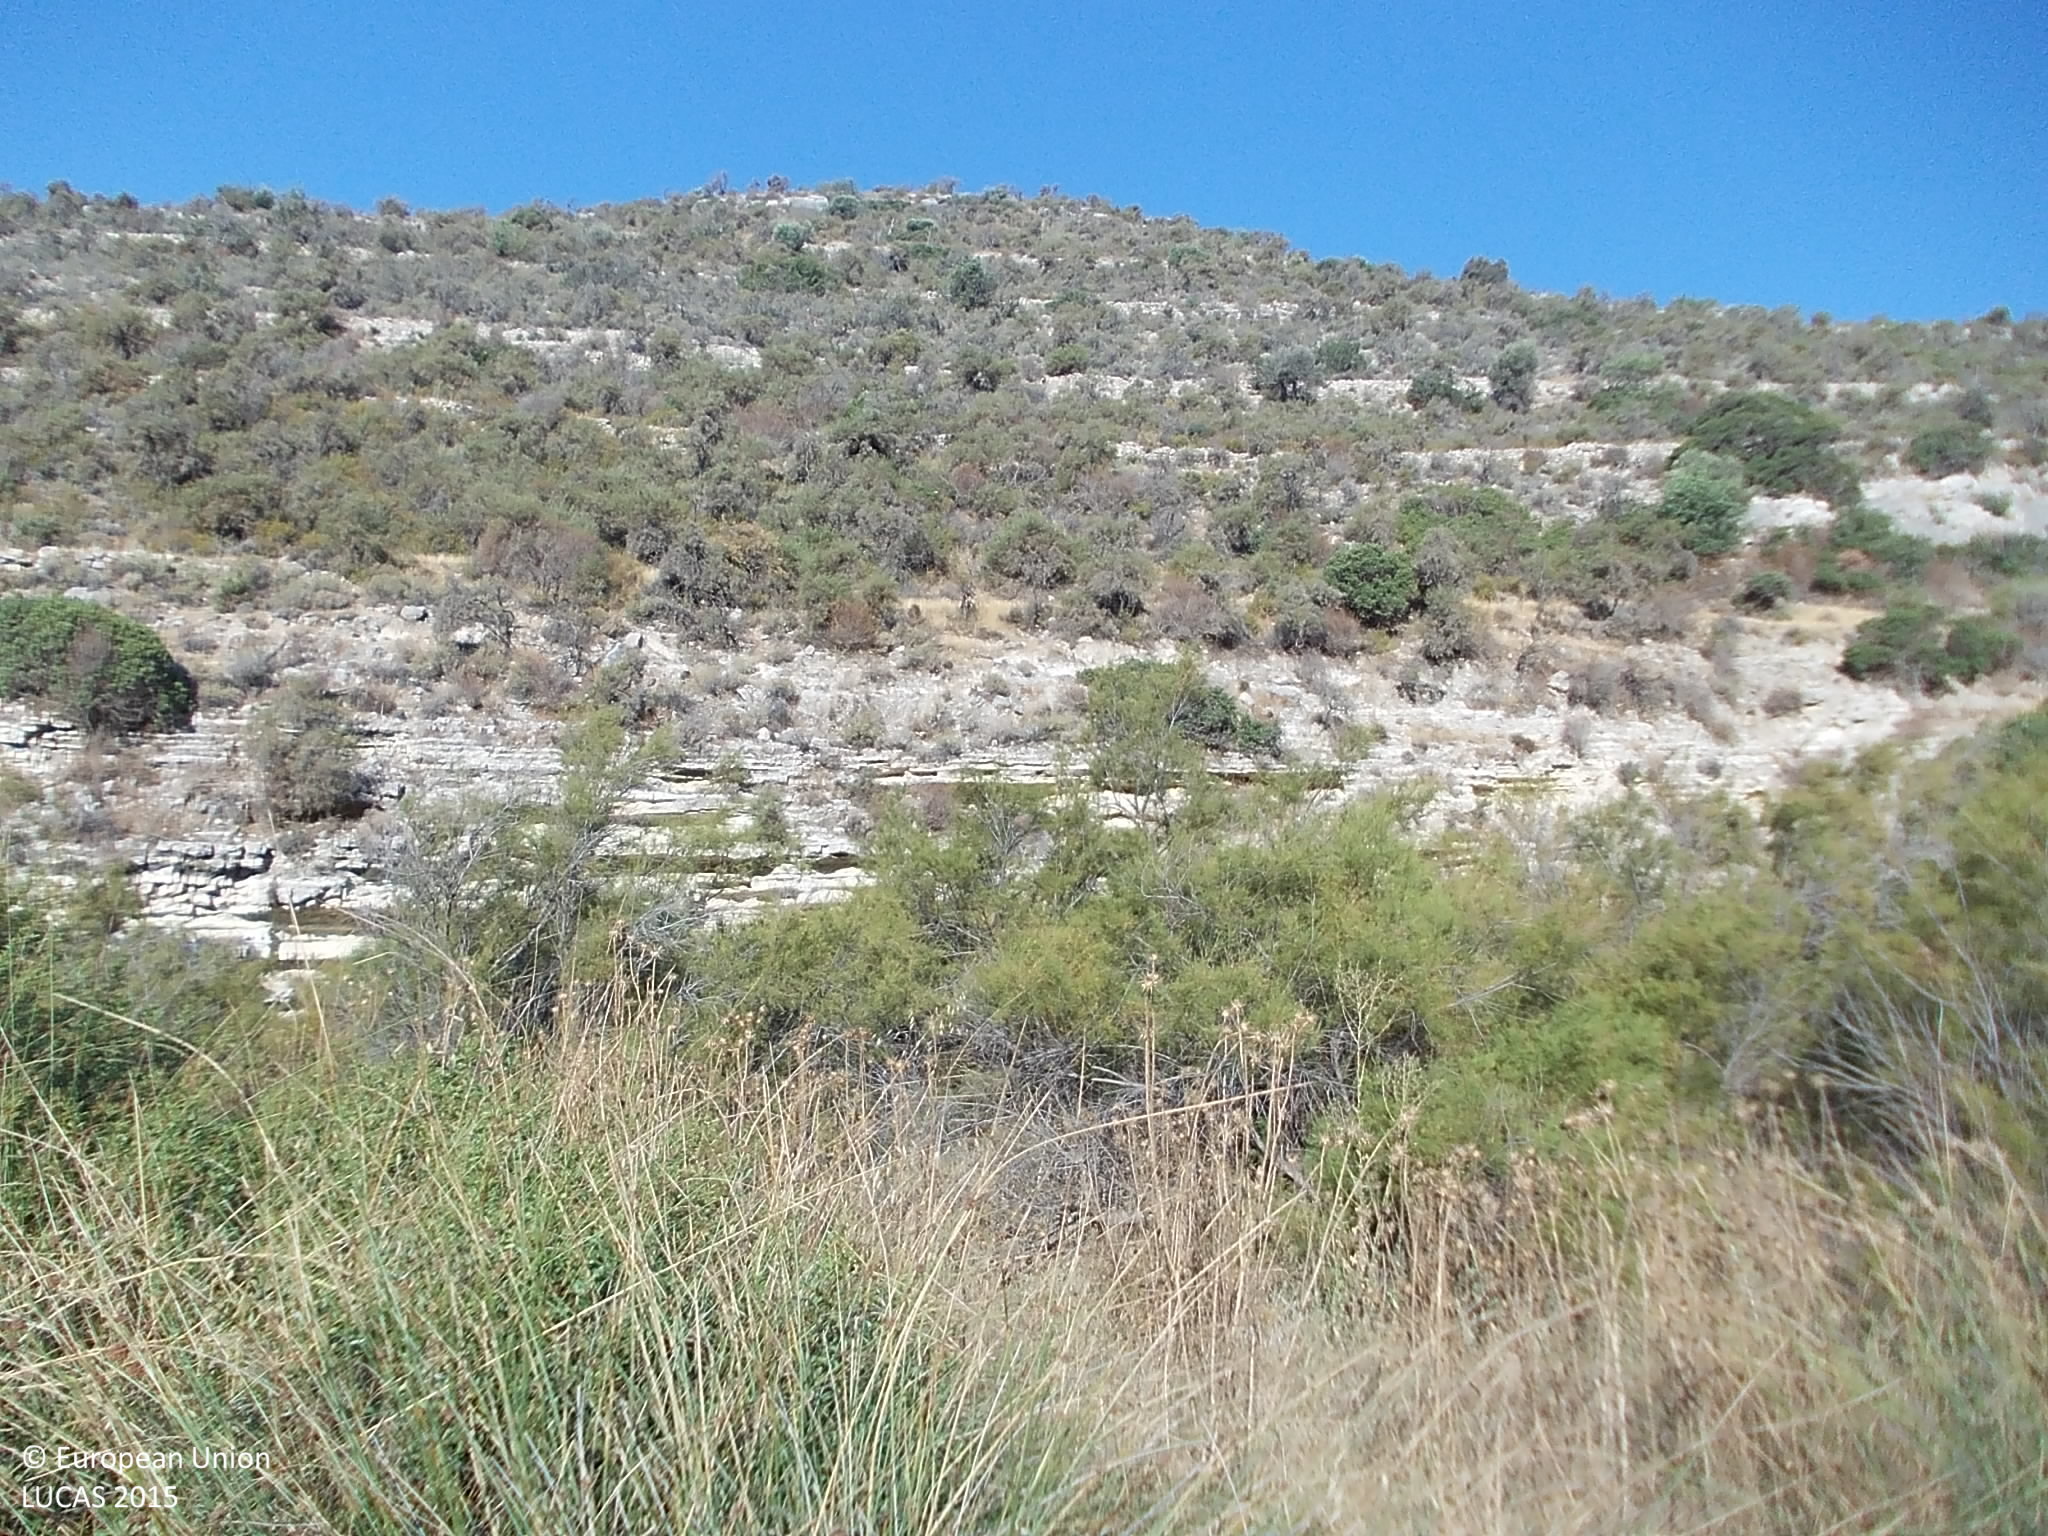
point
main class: Shrubland
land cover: Shrubland without tree cover
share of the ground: > 75 %
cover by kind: shrubs 85 %, herbaceous plants 10 %
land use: Semi-natural and natural areas not in use
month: August
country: CY
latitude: 34.7250
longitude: 32.9763
